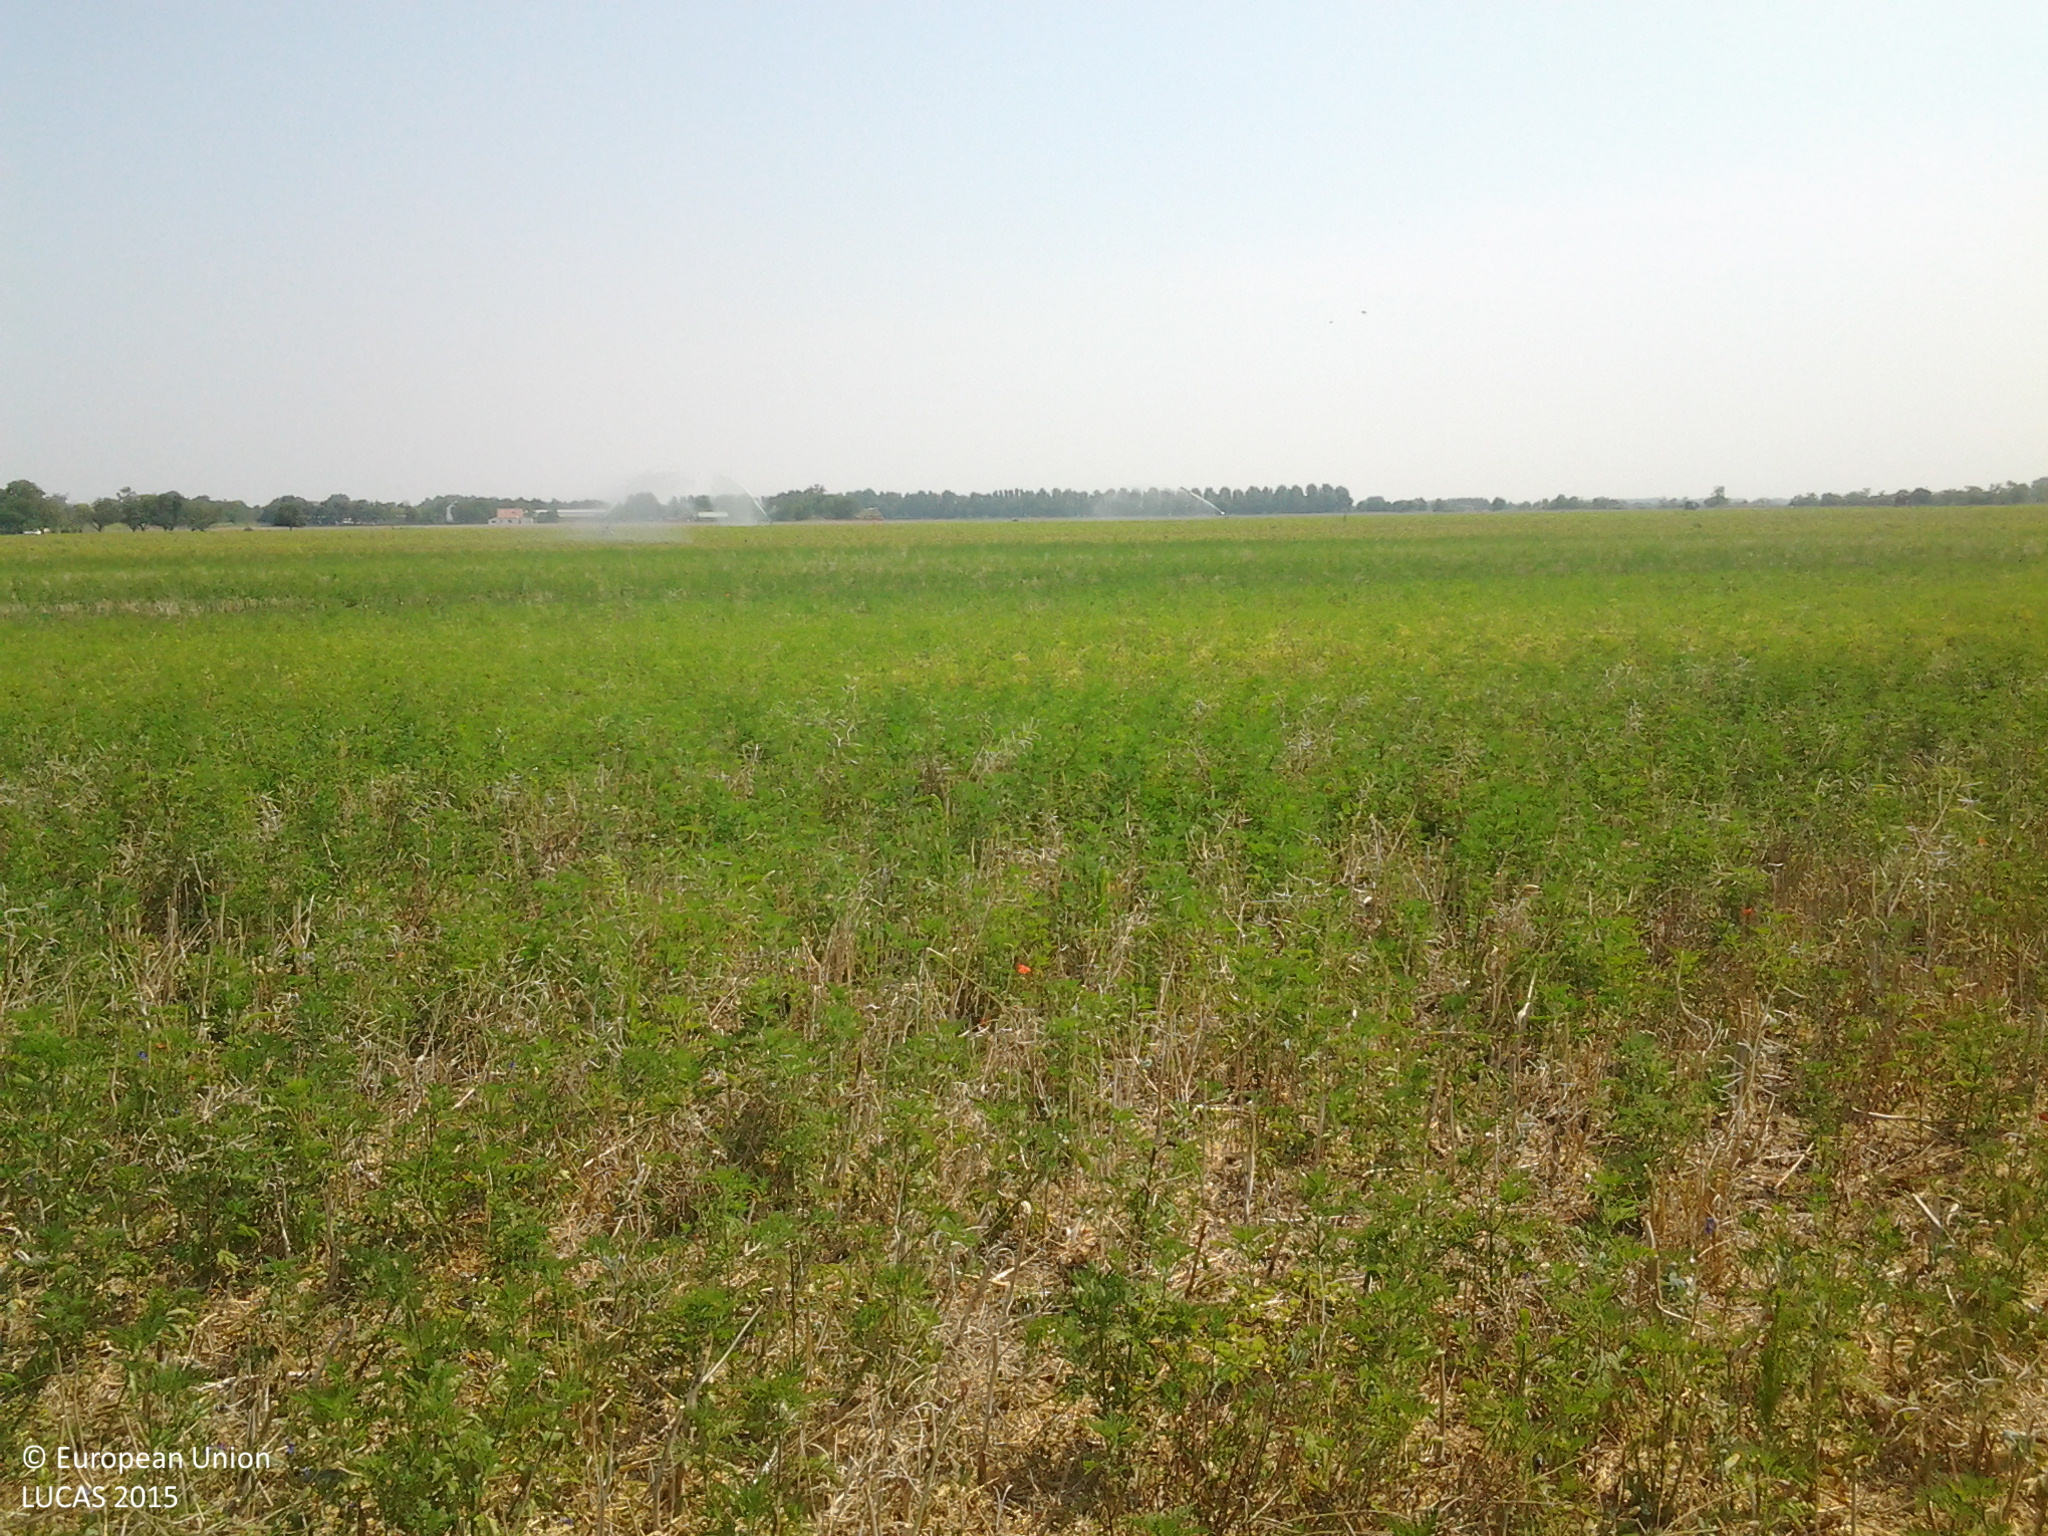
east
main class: Cropland
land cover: Rape and turnip rape
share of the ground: > 75 %
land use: Agriculture (excluding fallow land and kitchen gardens)
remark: Harvested field
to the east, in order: Rape and turnip rape; Potatoes
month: July
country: HU
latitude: 46.8545
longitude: 19.0521
